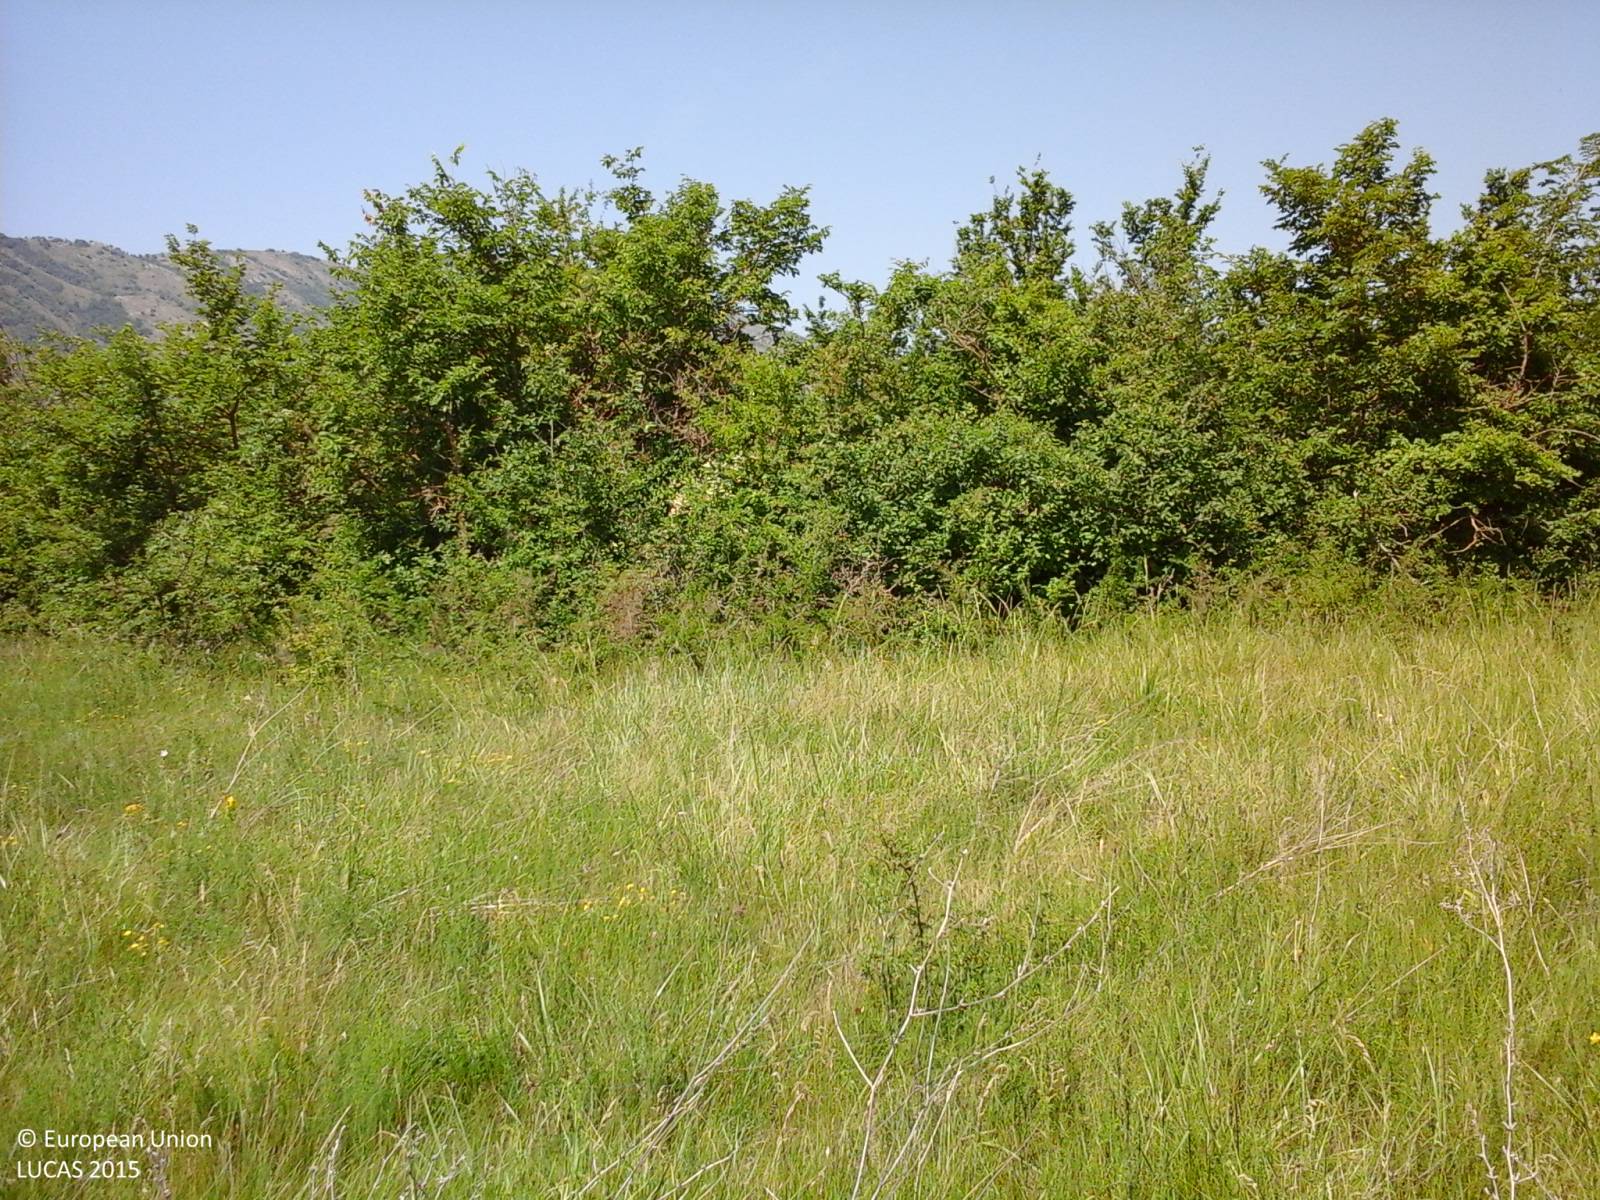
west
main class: Grassland
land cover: Grassland without tree/shrub cover
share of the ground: > 75 %
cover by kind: herbaceous plants 100 %
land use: Agriculture (excluding fallow land and kitchen gardens)
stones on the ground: < 10 %
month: June
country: IT
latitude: 42.0198
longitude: 13.3577
